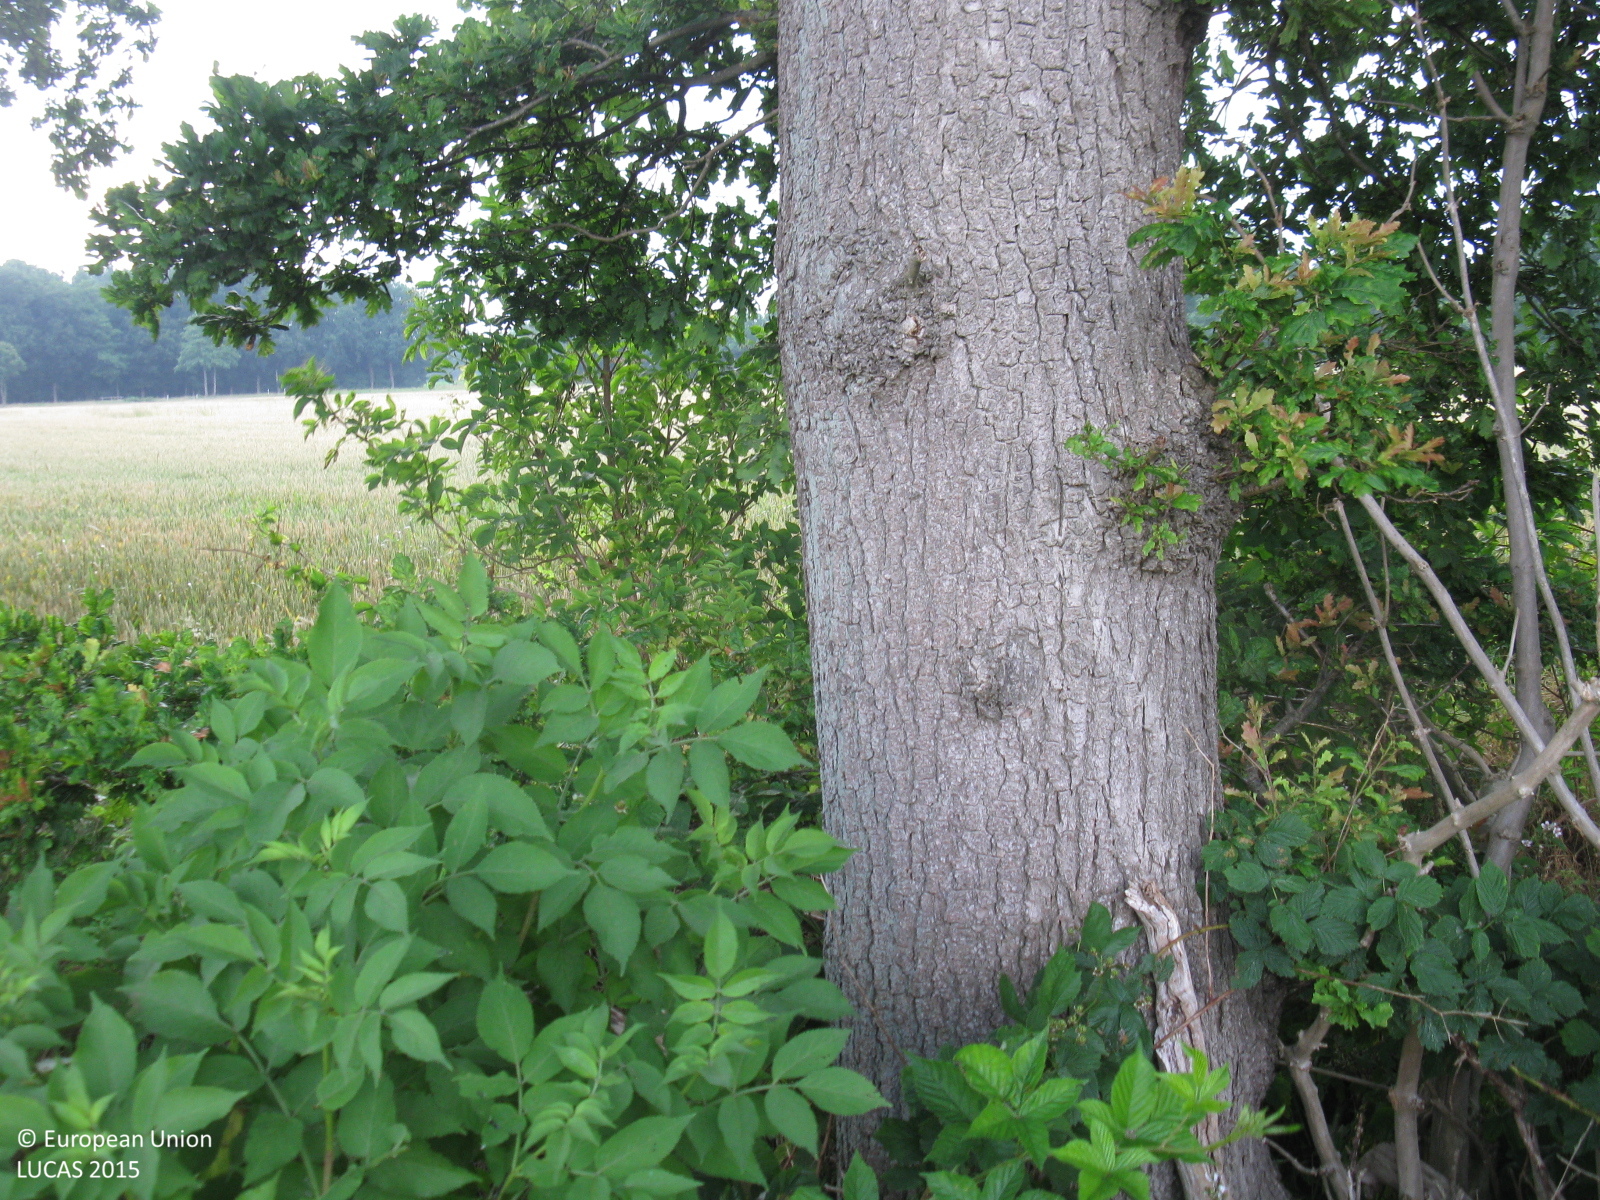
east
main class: Cropland
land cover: Maize
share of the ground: > 75 %
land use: Agriculture (excluding fallow land and kitchen gardens)
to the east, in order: Maize; Broadleaved woodland; Ditches and canals; Shruby margins; Common wheat; Grass margins; Ditches and canals; Grass margins; Common wheat
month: July
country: DE
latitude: 53.2412
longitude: 7.9778
